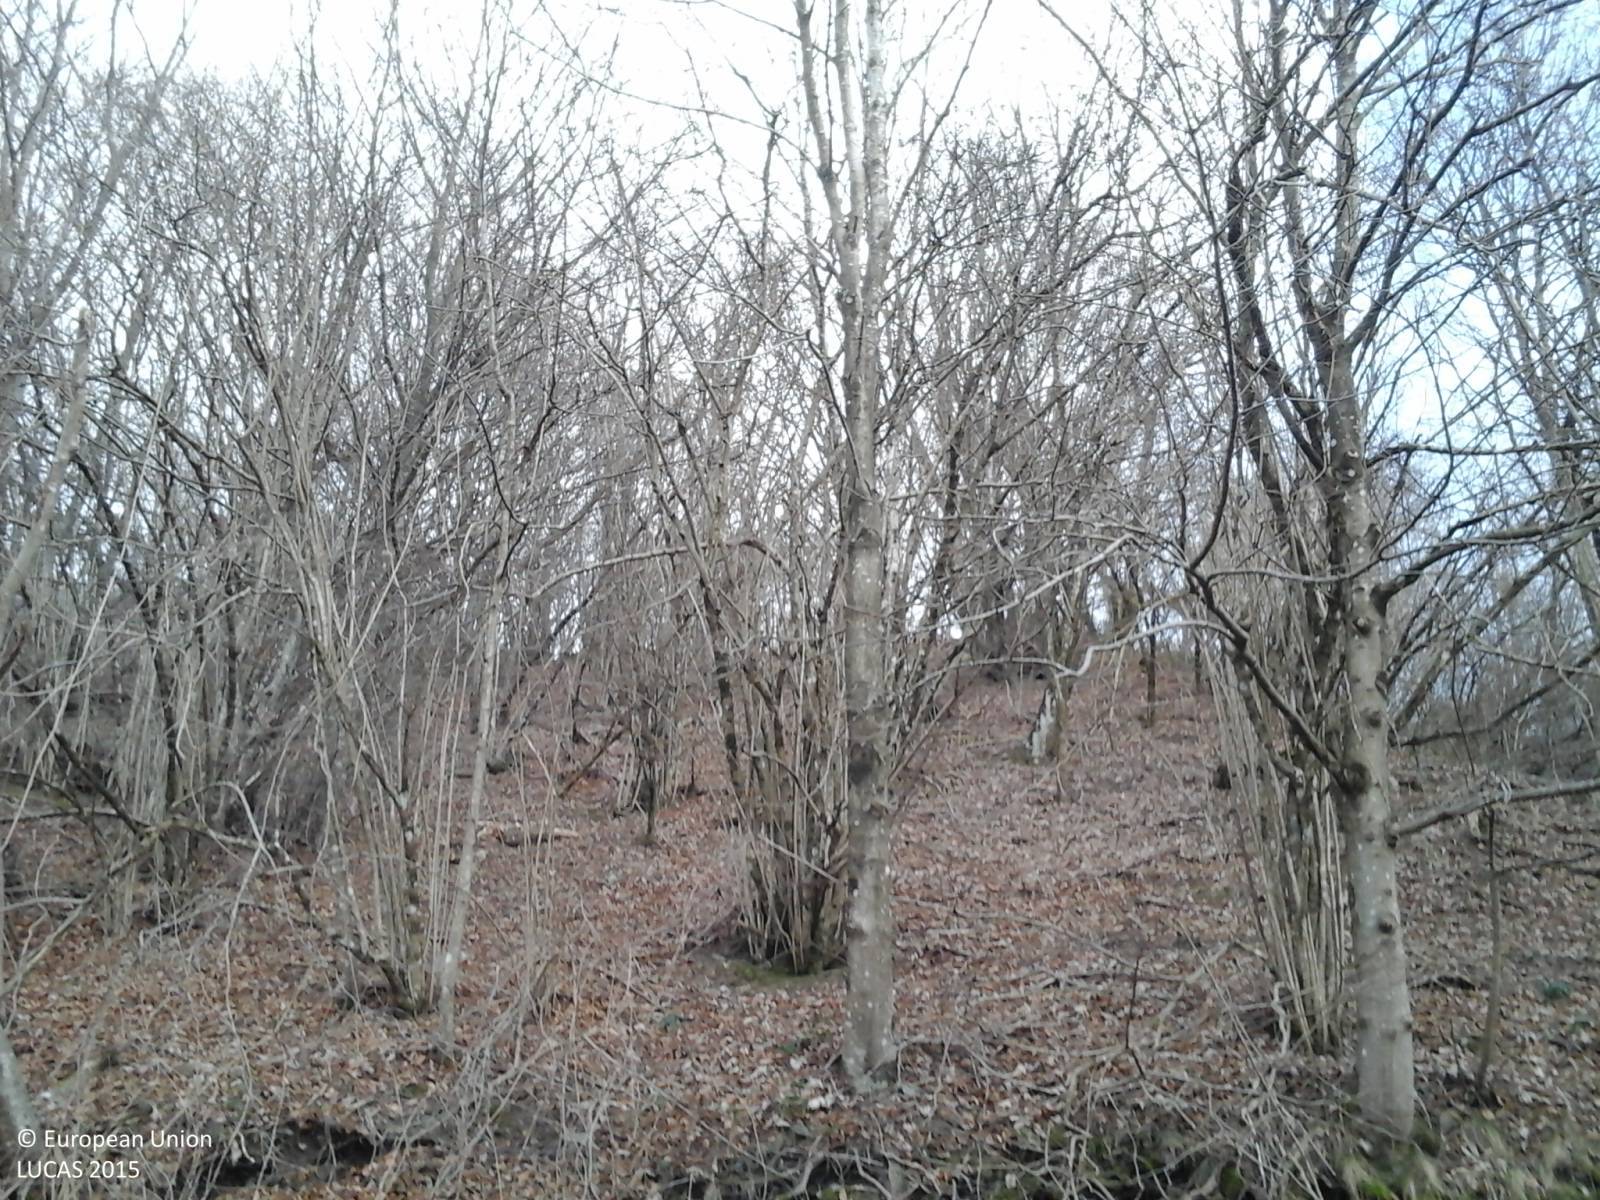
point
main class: Woodland
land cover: Broadleaved woodland
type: mesophytic deciduous forest
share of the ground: > 75 %
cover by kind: broadleaved forest trees 100 %
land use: Forestry
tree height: > 5 m
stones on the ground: 10 - 25 %
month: January
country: IT
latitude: 44.4916
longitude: 9.1844
